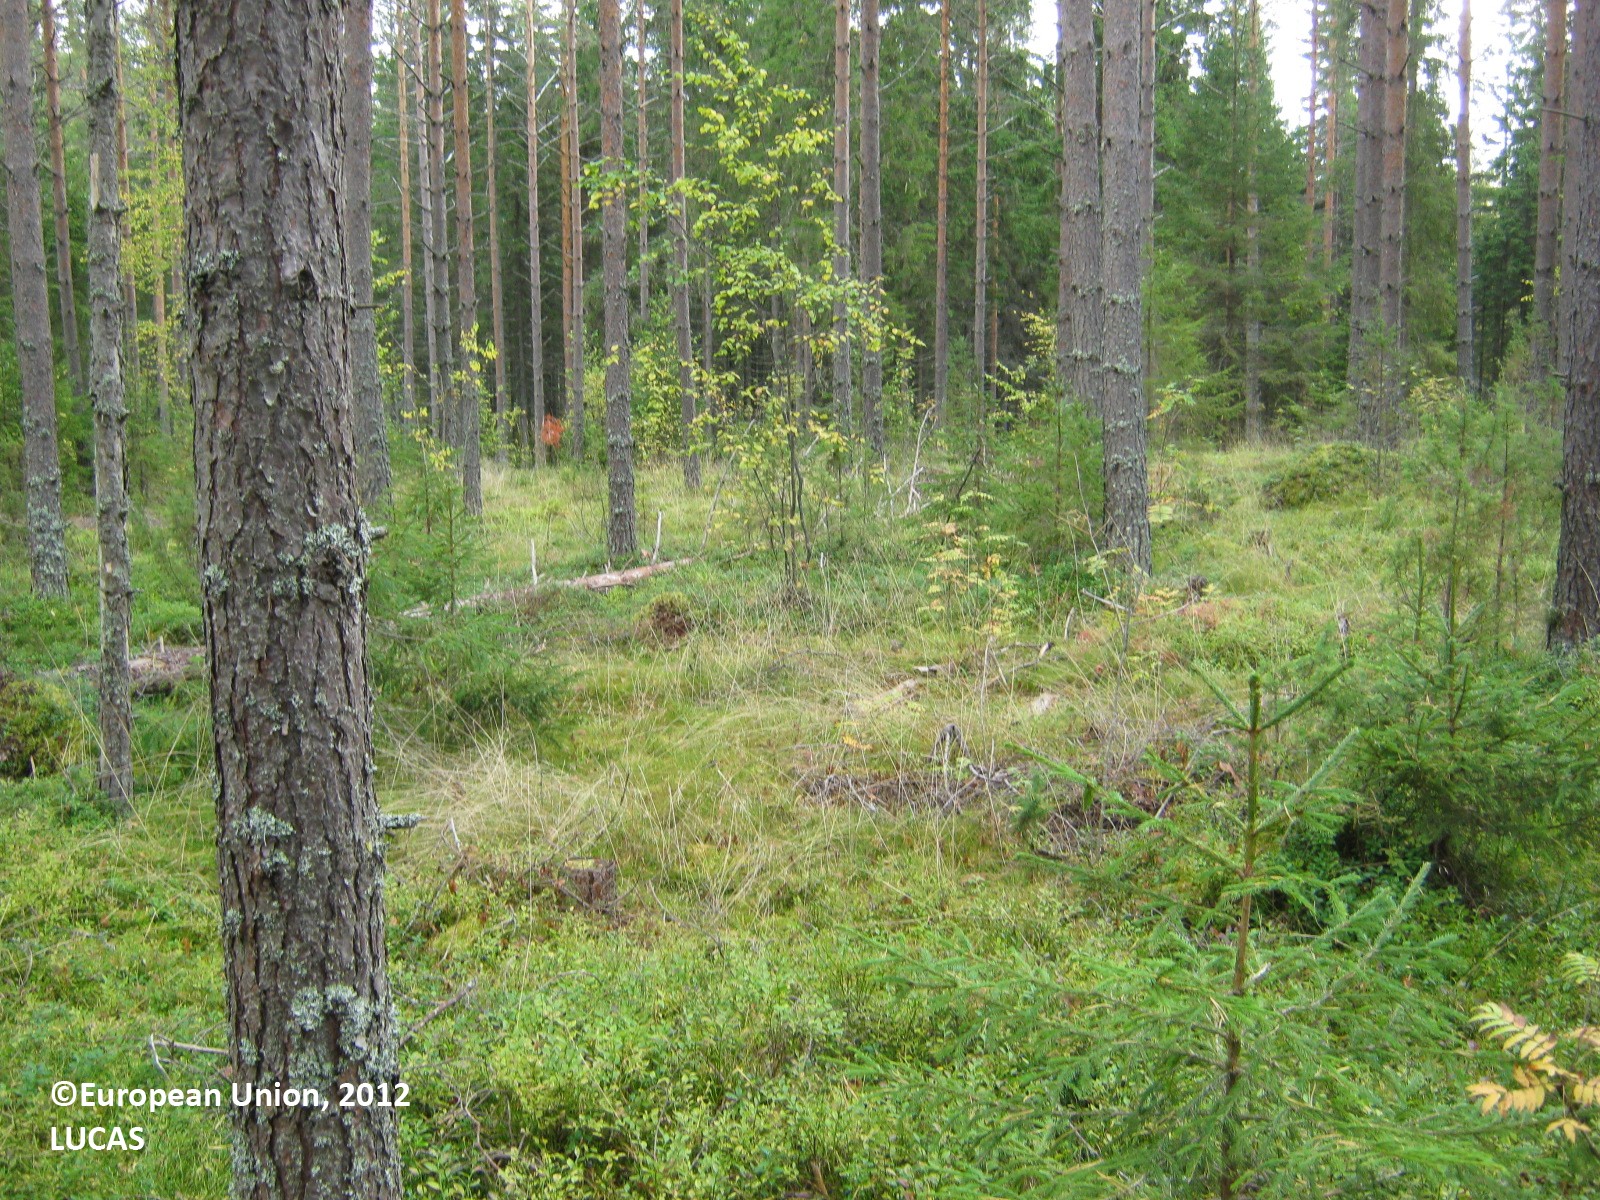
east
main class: Woodland
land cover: Pine dominated coniferous woodland
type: boreal forest
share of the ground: 50 - 75 %
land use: Forestry
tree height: > 5 m
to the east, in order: Pine dominated coniferous woodland; Tracks; Spruce dominated coniferous woodland; Spruce dominated mixed woodland; Broadleaved woodland; Inland water bodies
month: September
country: FI
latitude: 60.8525
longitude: 28.0747
